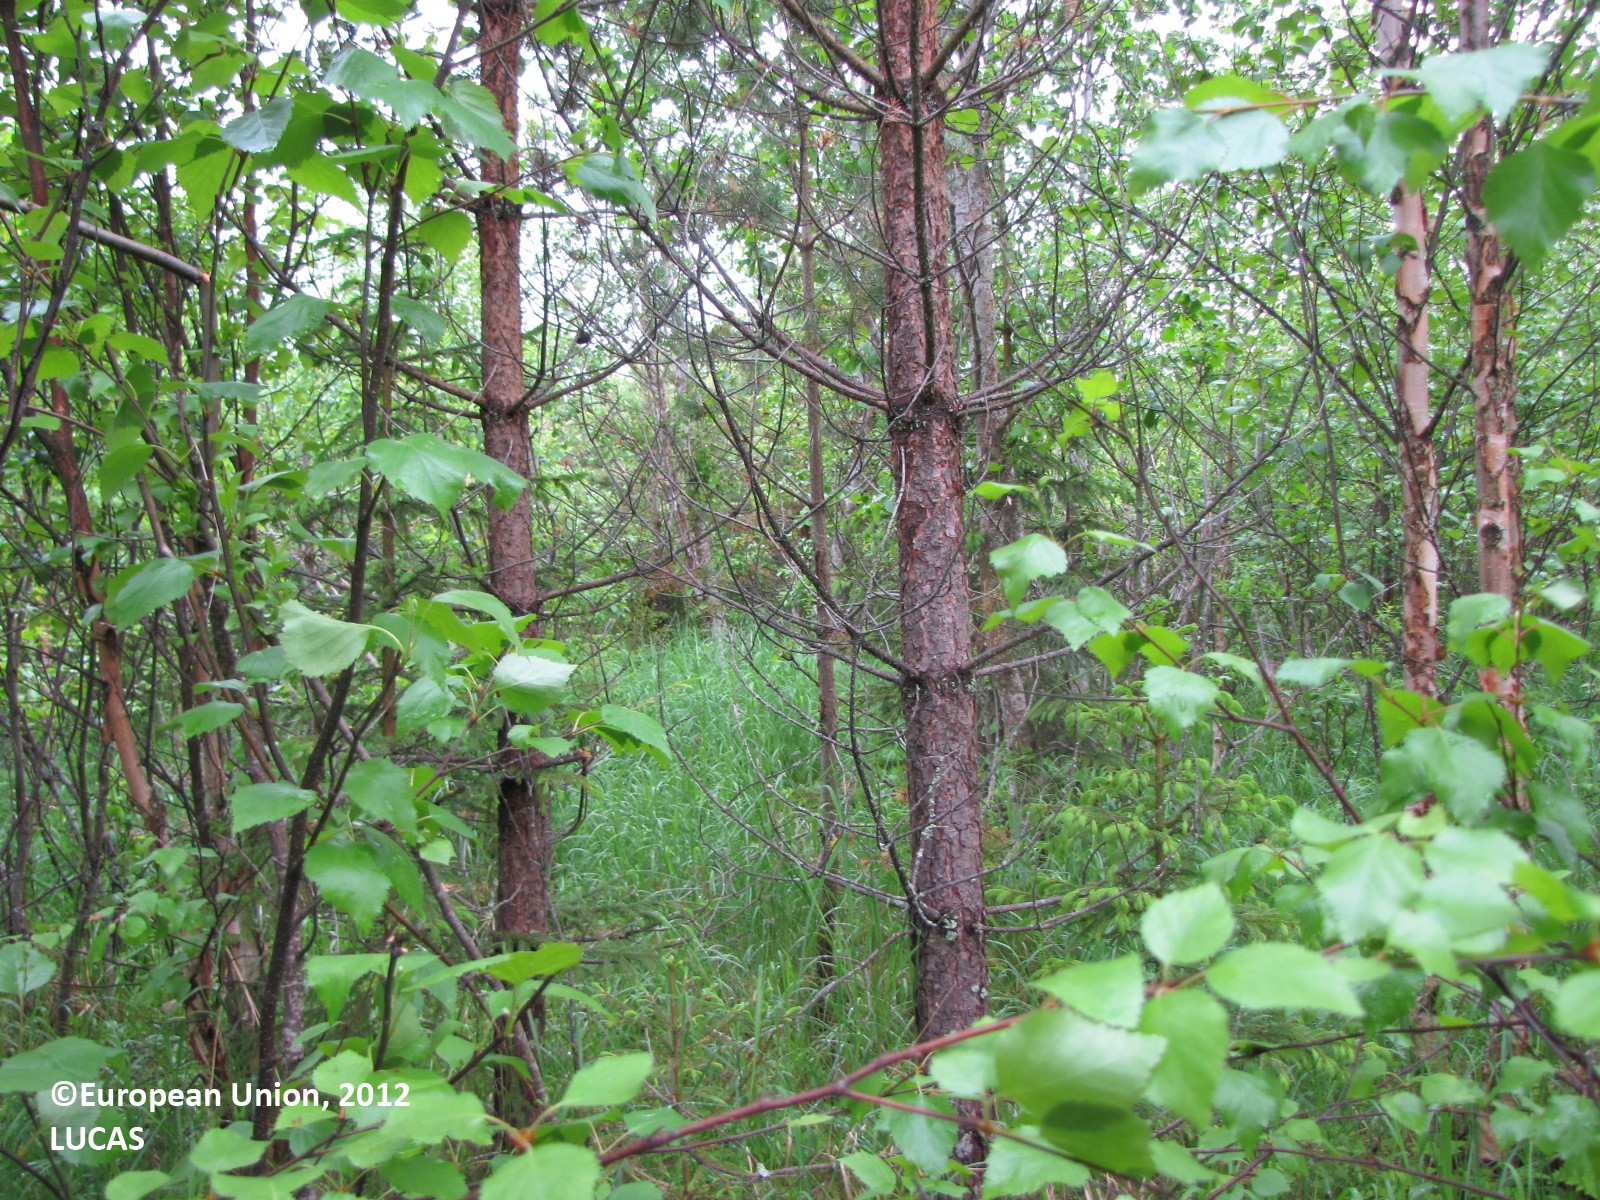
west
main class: Woodland
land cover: Other mixed woodland
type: boreal forest
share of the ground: > 75 %
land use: Forestry
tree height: > 5 m
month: June
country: FI
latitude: 66.0020
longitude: 24.4389
